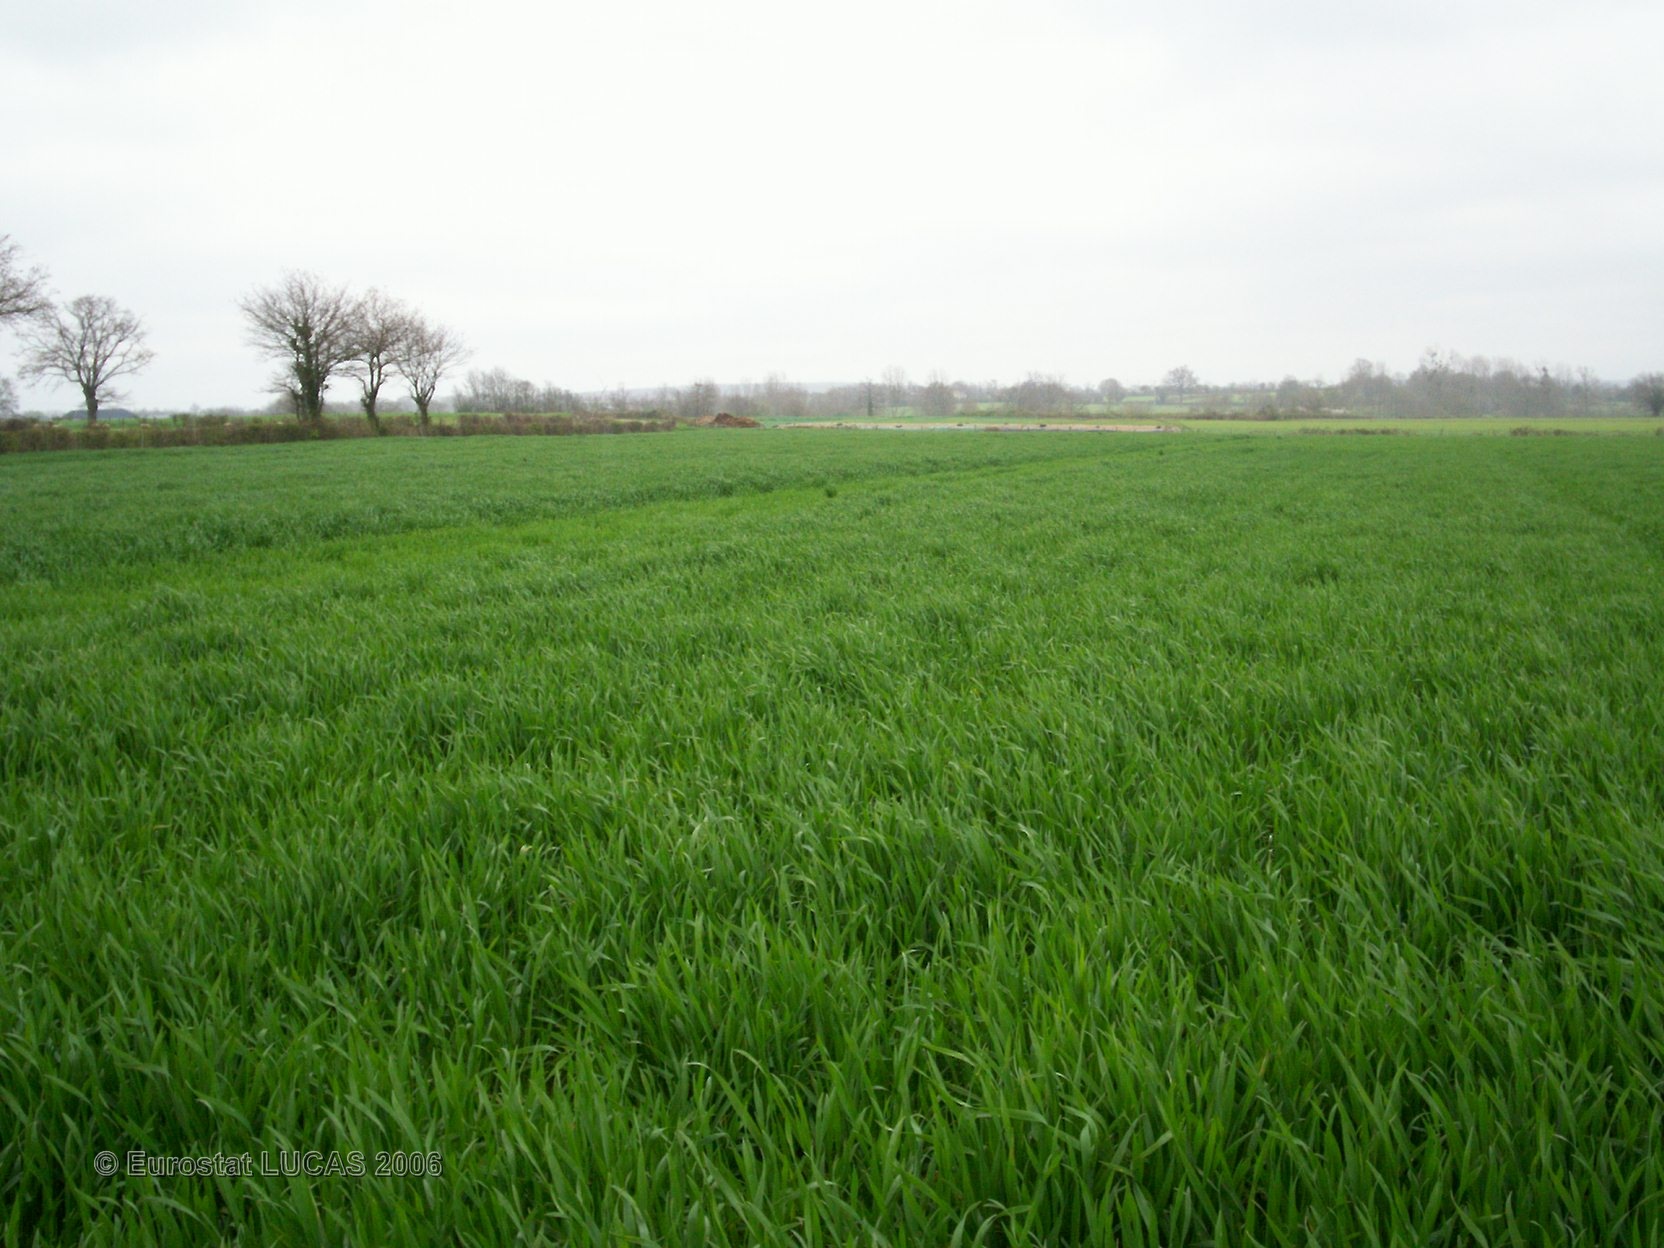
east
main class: Cropland
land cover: Common wheat
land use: Agriculture (excluding fallow land and kitchen gardens)
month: April
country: FR
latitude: 46.8488
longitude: -0.3210
